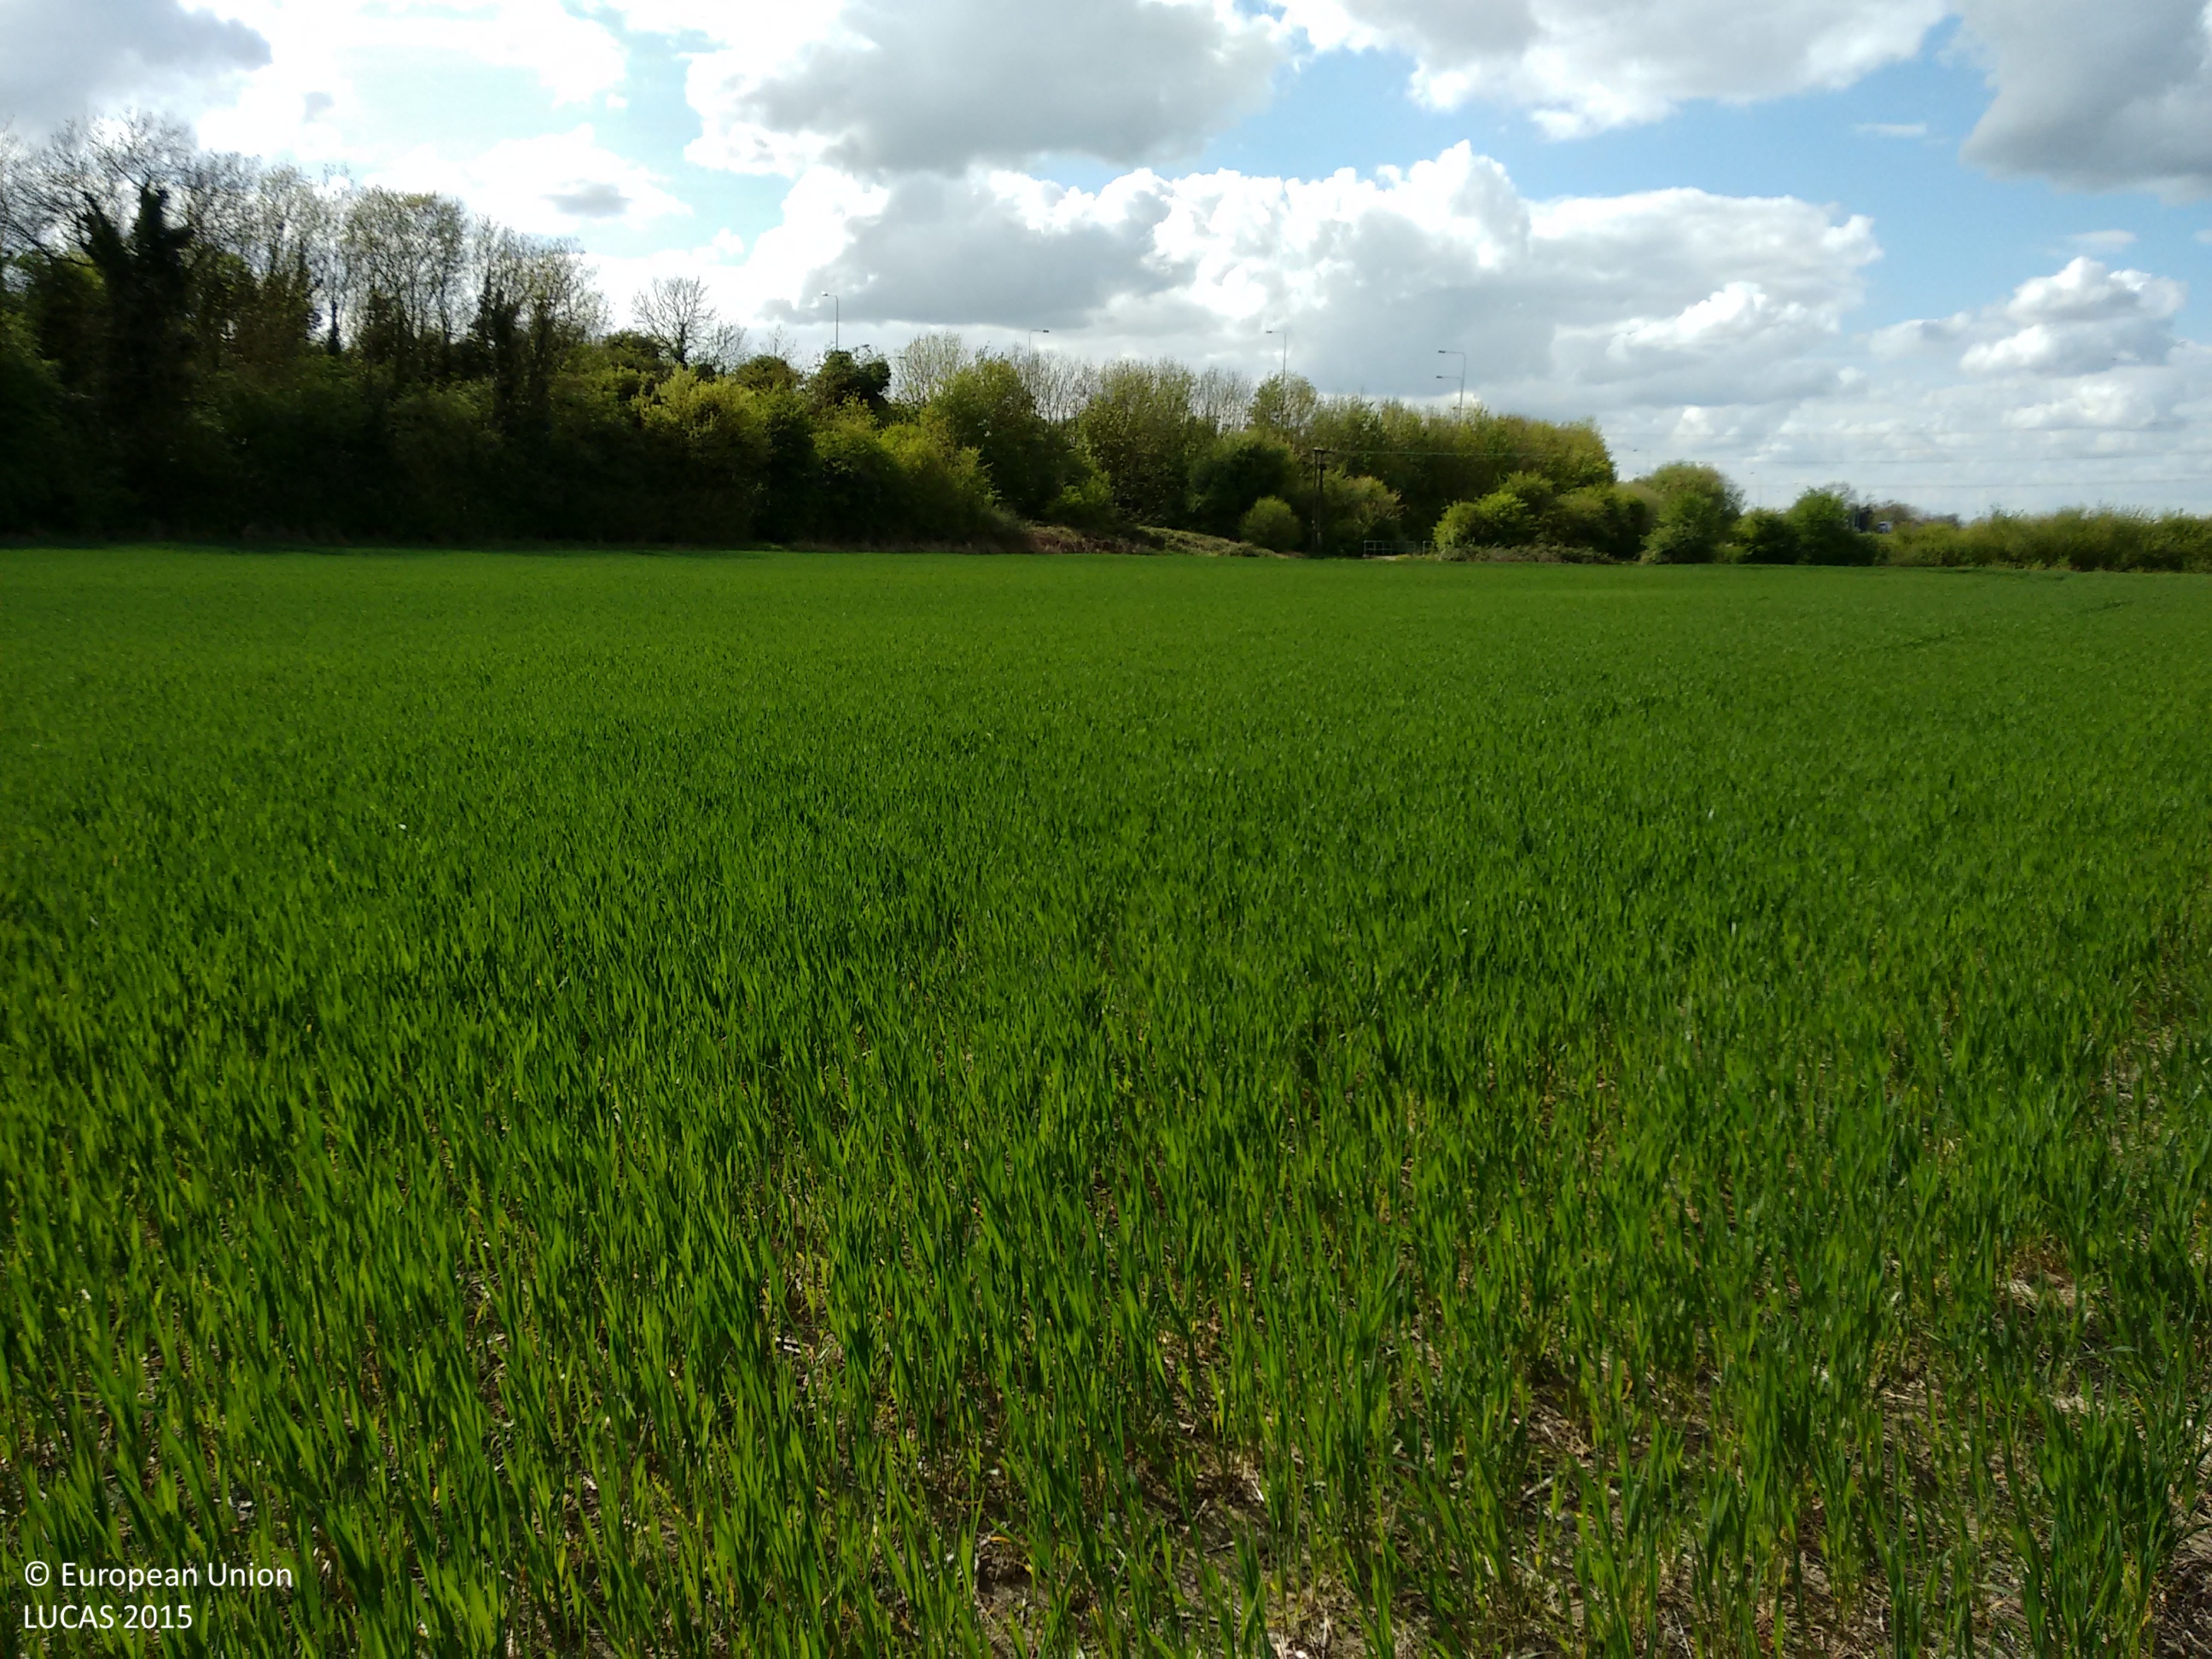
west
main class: Woodland
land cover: Broadleaved woodland
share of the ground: > 75 %
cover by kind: broadleaved forest trees 50 %, herbaceous plants 50 %
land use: Semi-natural and natural areas not in use
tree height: < 5 m
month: May
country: GB
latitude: 51.9062
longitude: -0.5480
